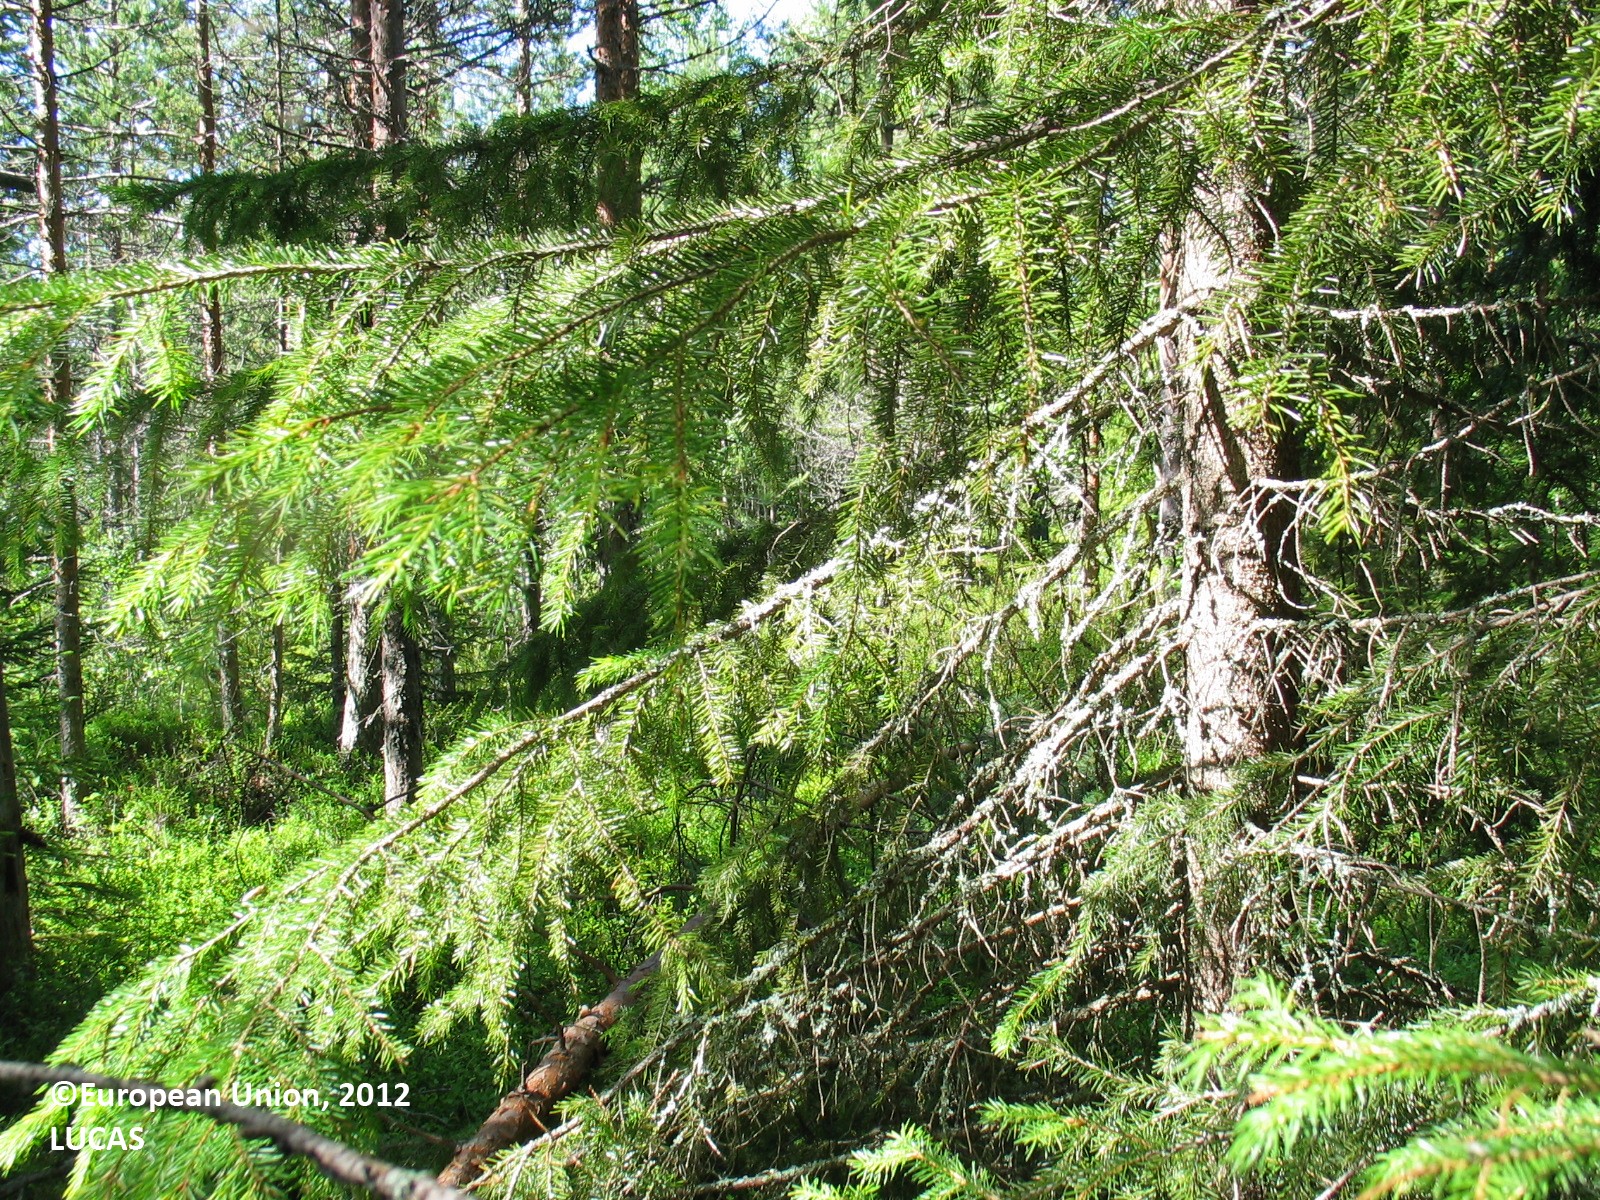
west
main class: Woodland
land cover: Pine dominated coniferous woodland
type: mire and swamp forests
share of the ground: 50 - 75 %
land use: Forestry
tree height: > 5 m
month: July
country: FI
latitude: 65.8180
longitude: 25.0500
